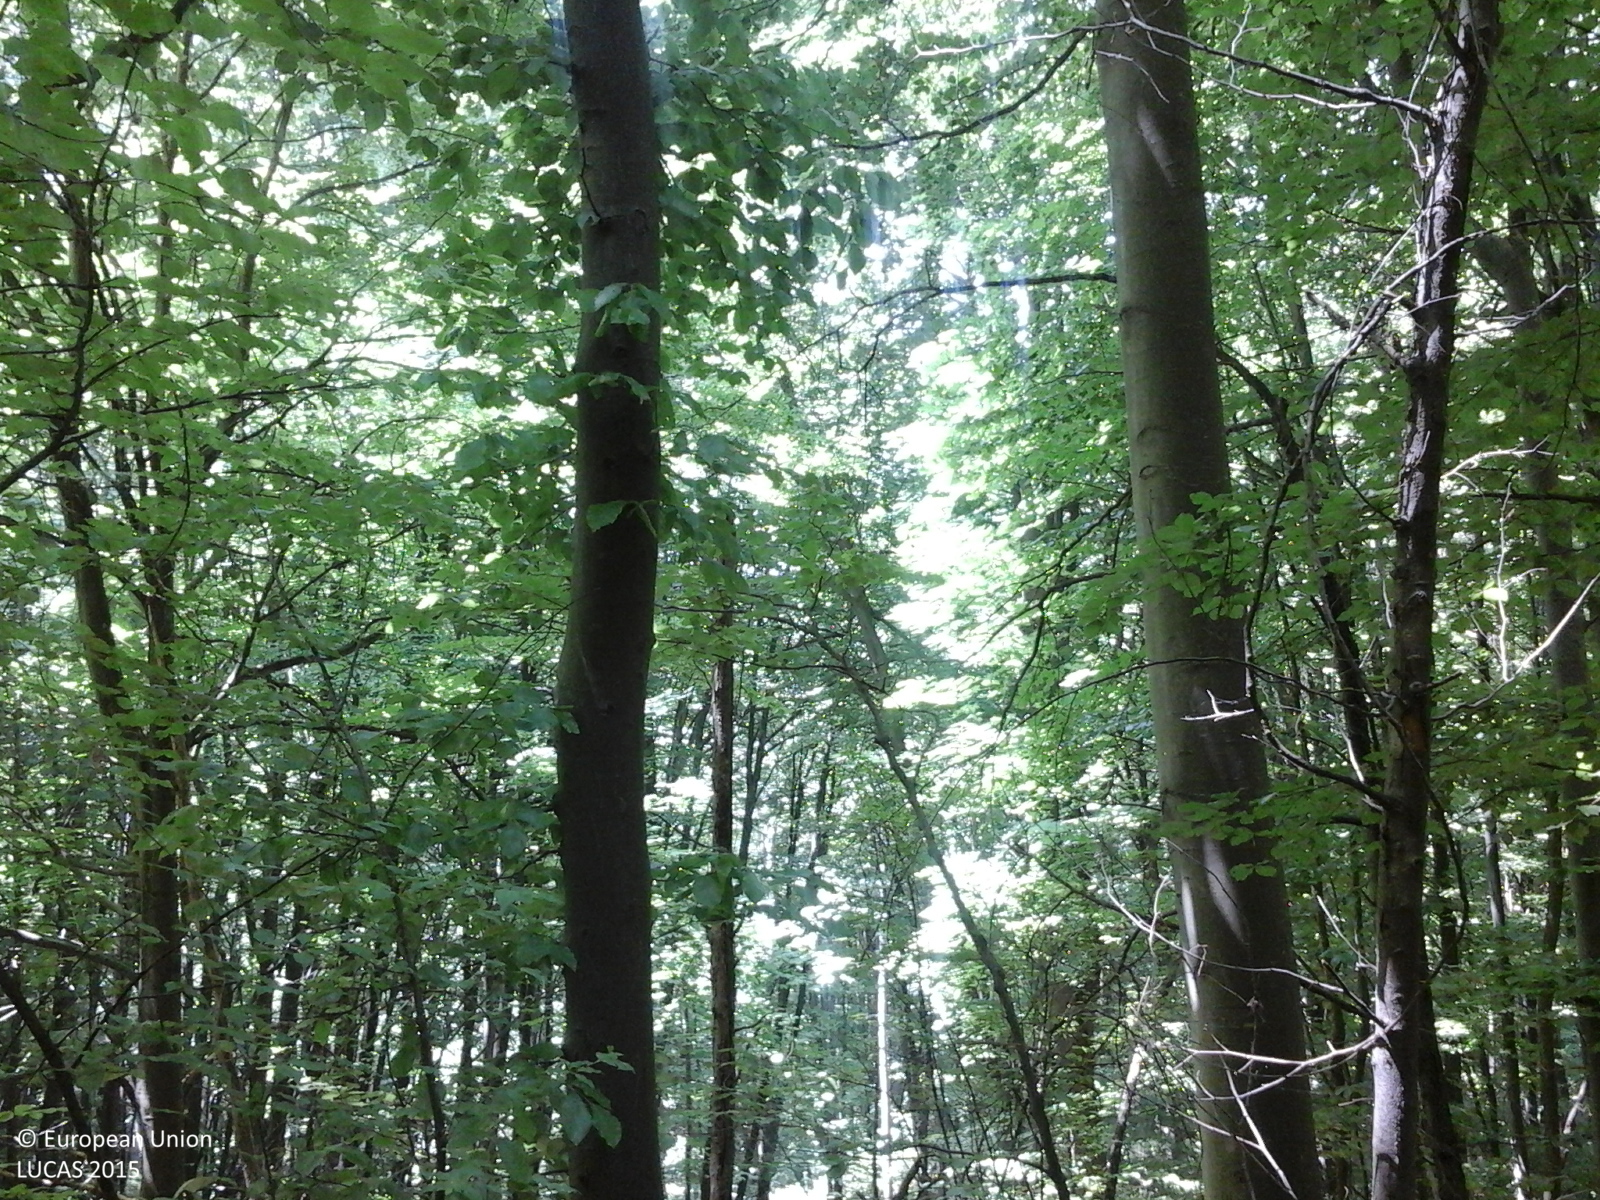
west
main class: Woodland
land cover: Broadleaved woodland
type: beech forest
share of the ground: > 75 %
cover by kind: broadleaved forest trees 100 %
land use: Forestry
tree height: > 5 m
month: June
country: RO
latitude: 46.6015
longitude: 26.7337
